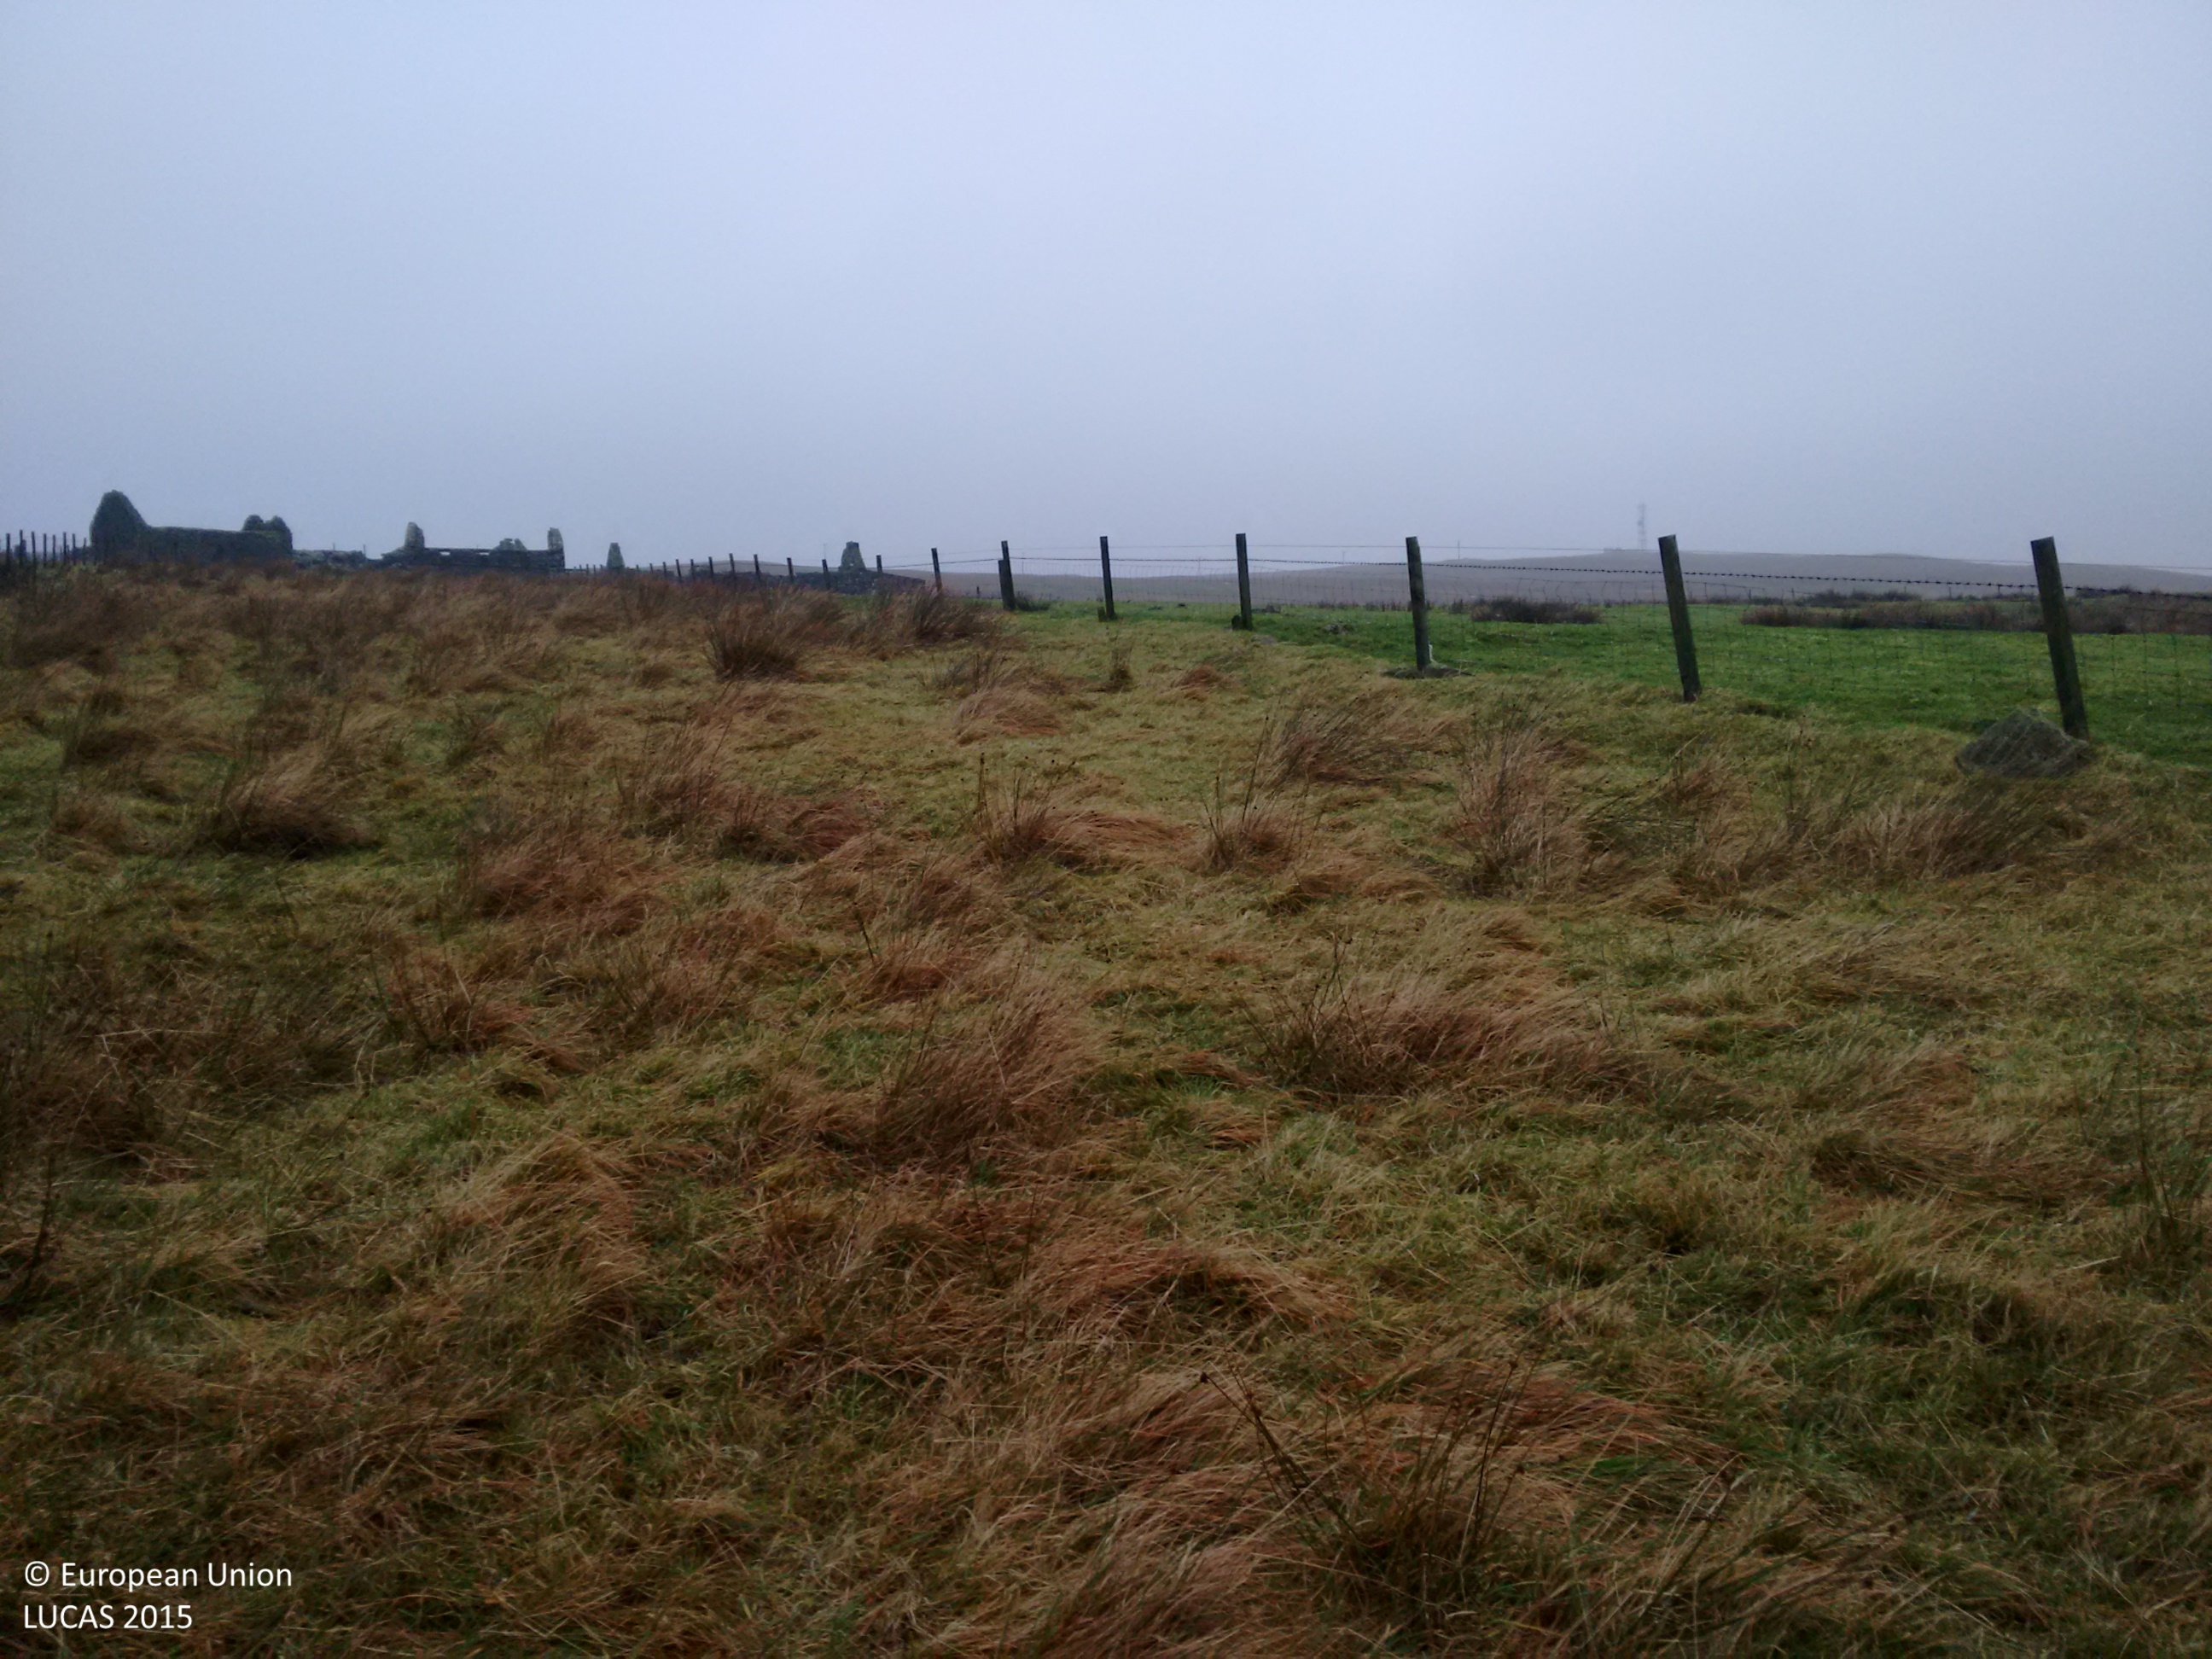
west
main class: Grassland
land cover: Grassland without tree/shrub cover
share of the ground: > 75 %
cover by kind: herbaceous plants 100 %
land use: Agriculture (excluding fallow land and kitchen gardens)
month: November
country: GB
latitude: 60.4793
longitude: -1.2062
